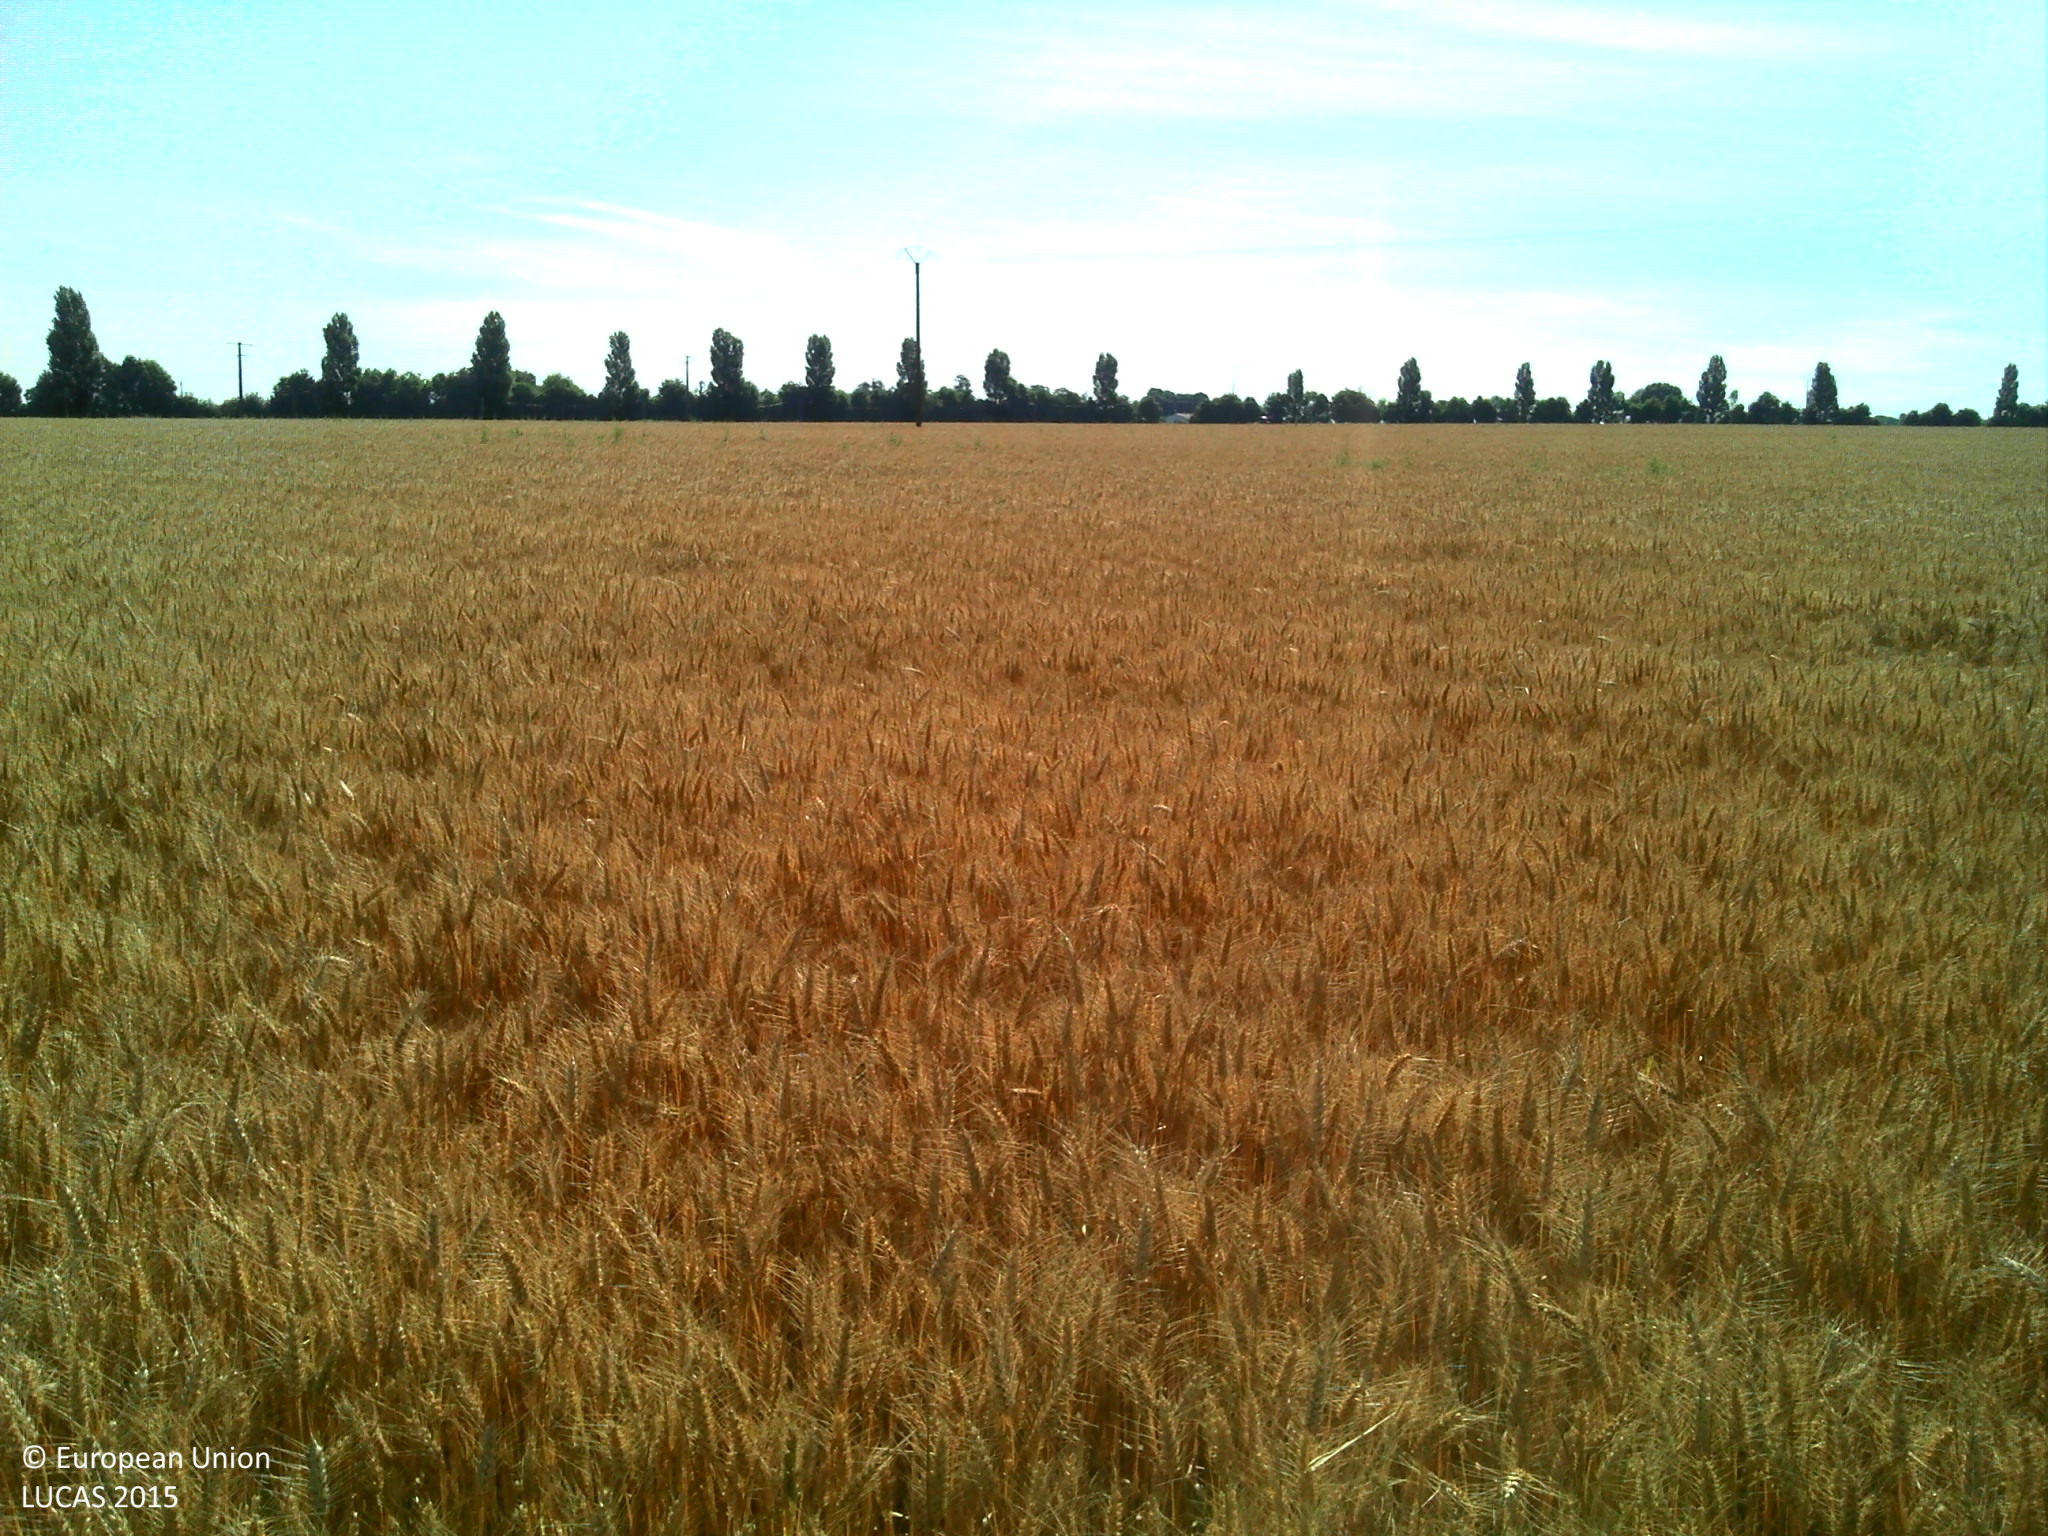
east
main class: Cropland
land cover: Durum wheat
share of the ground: > 75 %
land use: Agriculture (excluding fallow land and kitchen gardens)
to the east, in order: Durum wheat; Electric lines; Durum wheat
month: June
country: FR
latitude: 45.8109
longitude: -0.7192
